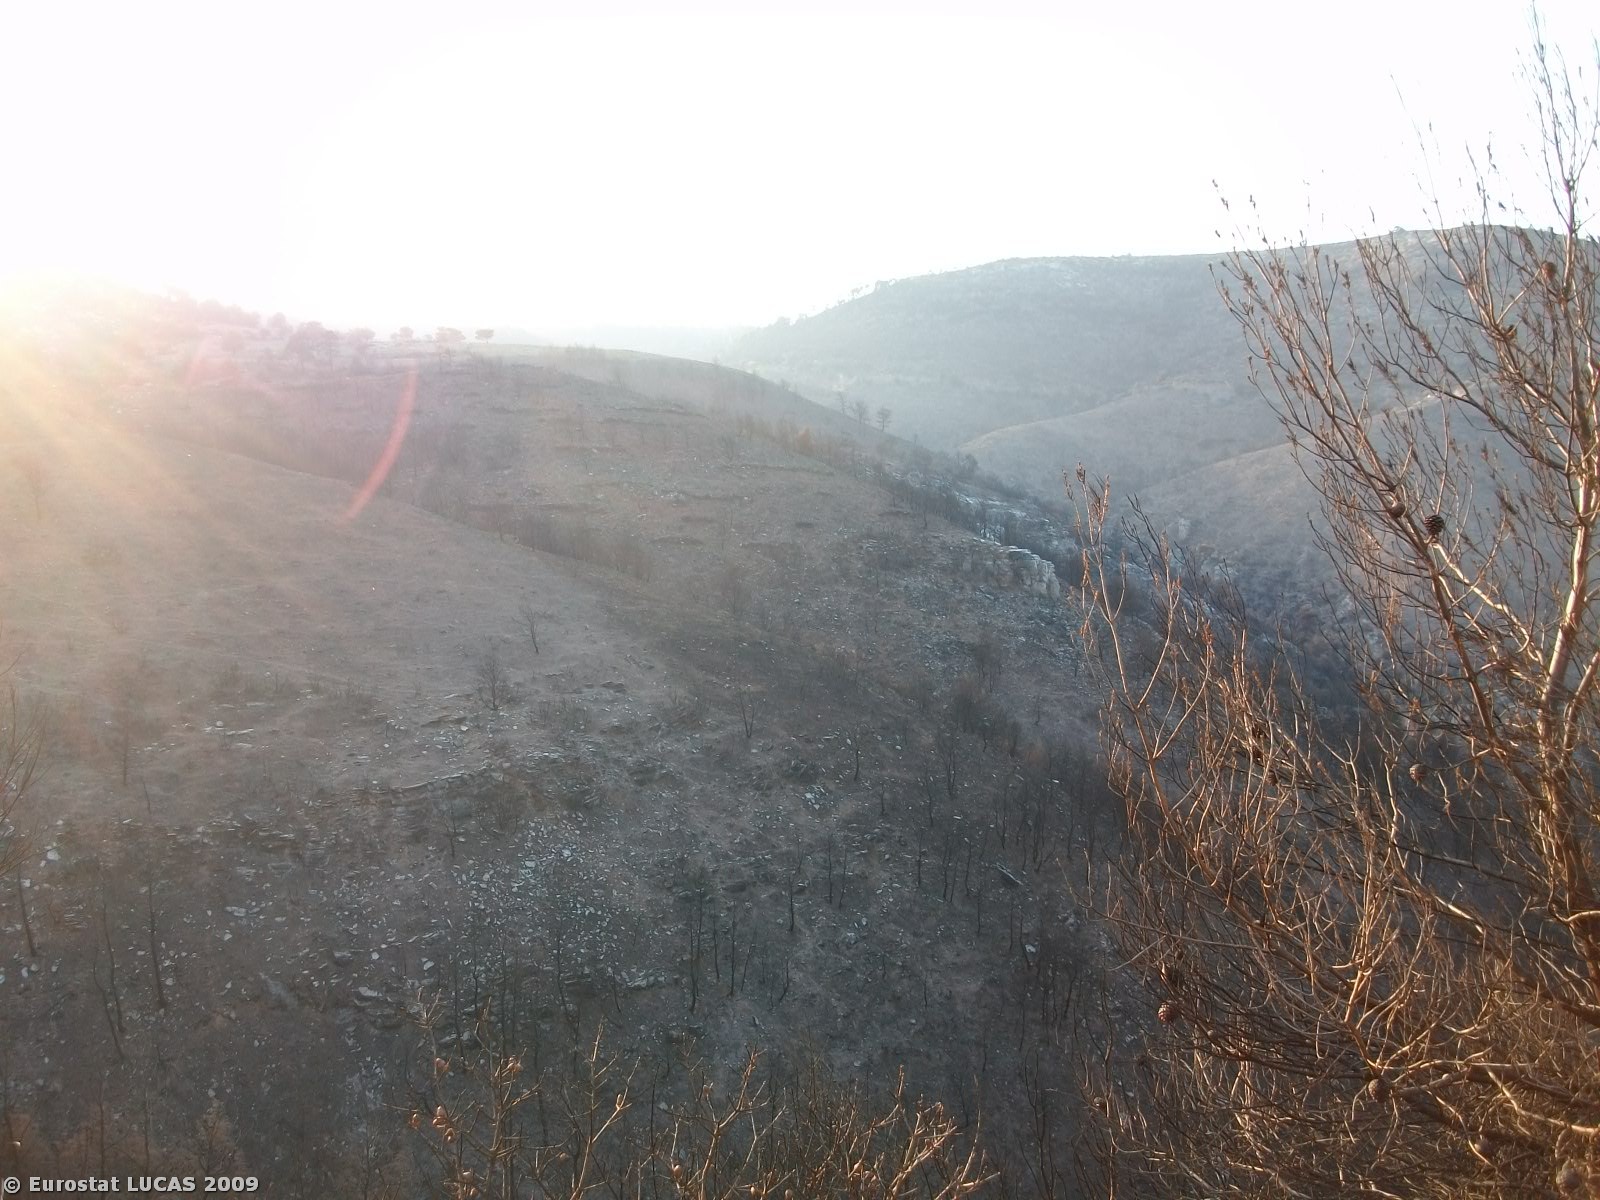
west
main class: Grassland
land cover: Grassland with sparse tree/shrub cover
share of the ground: > 75 %
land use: Unused
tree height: > 5 m
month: September
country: GR
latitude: 38.2367
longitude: 23.9594
